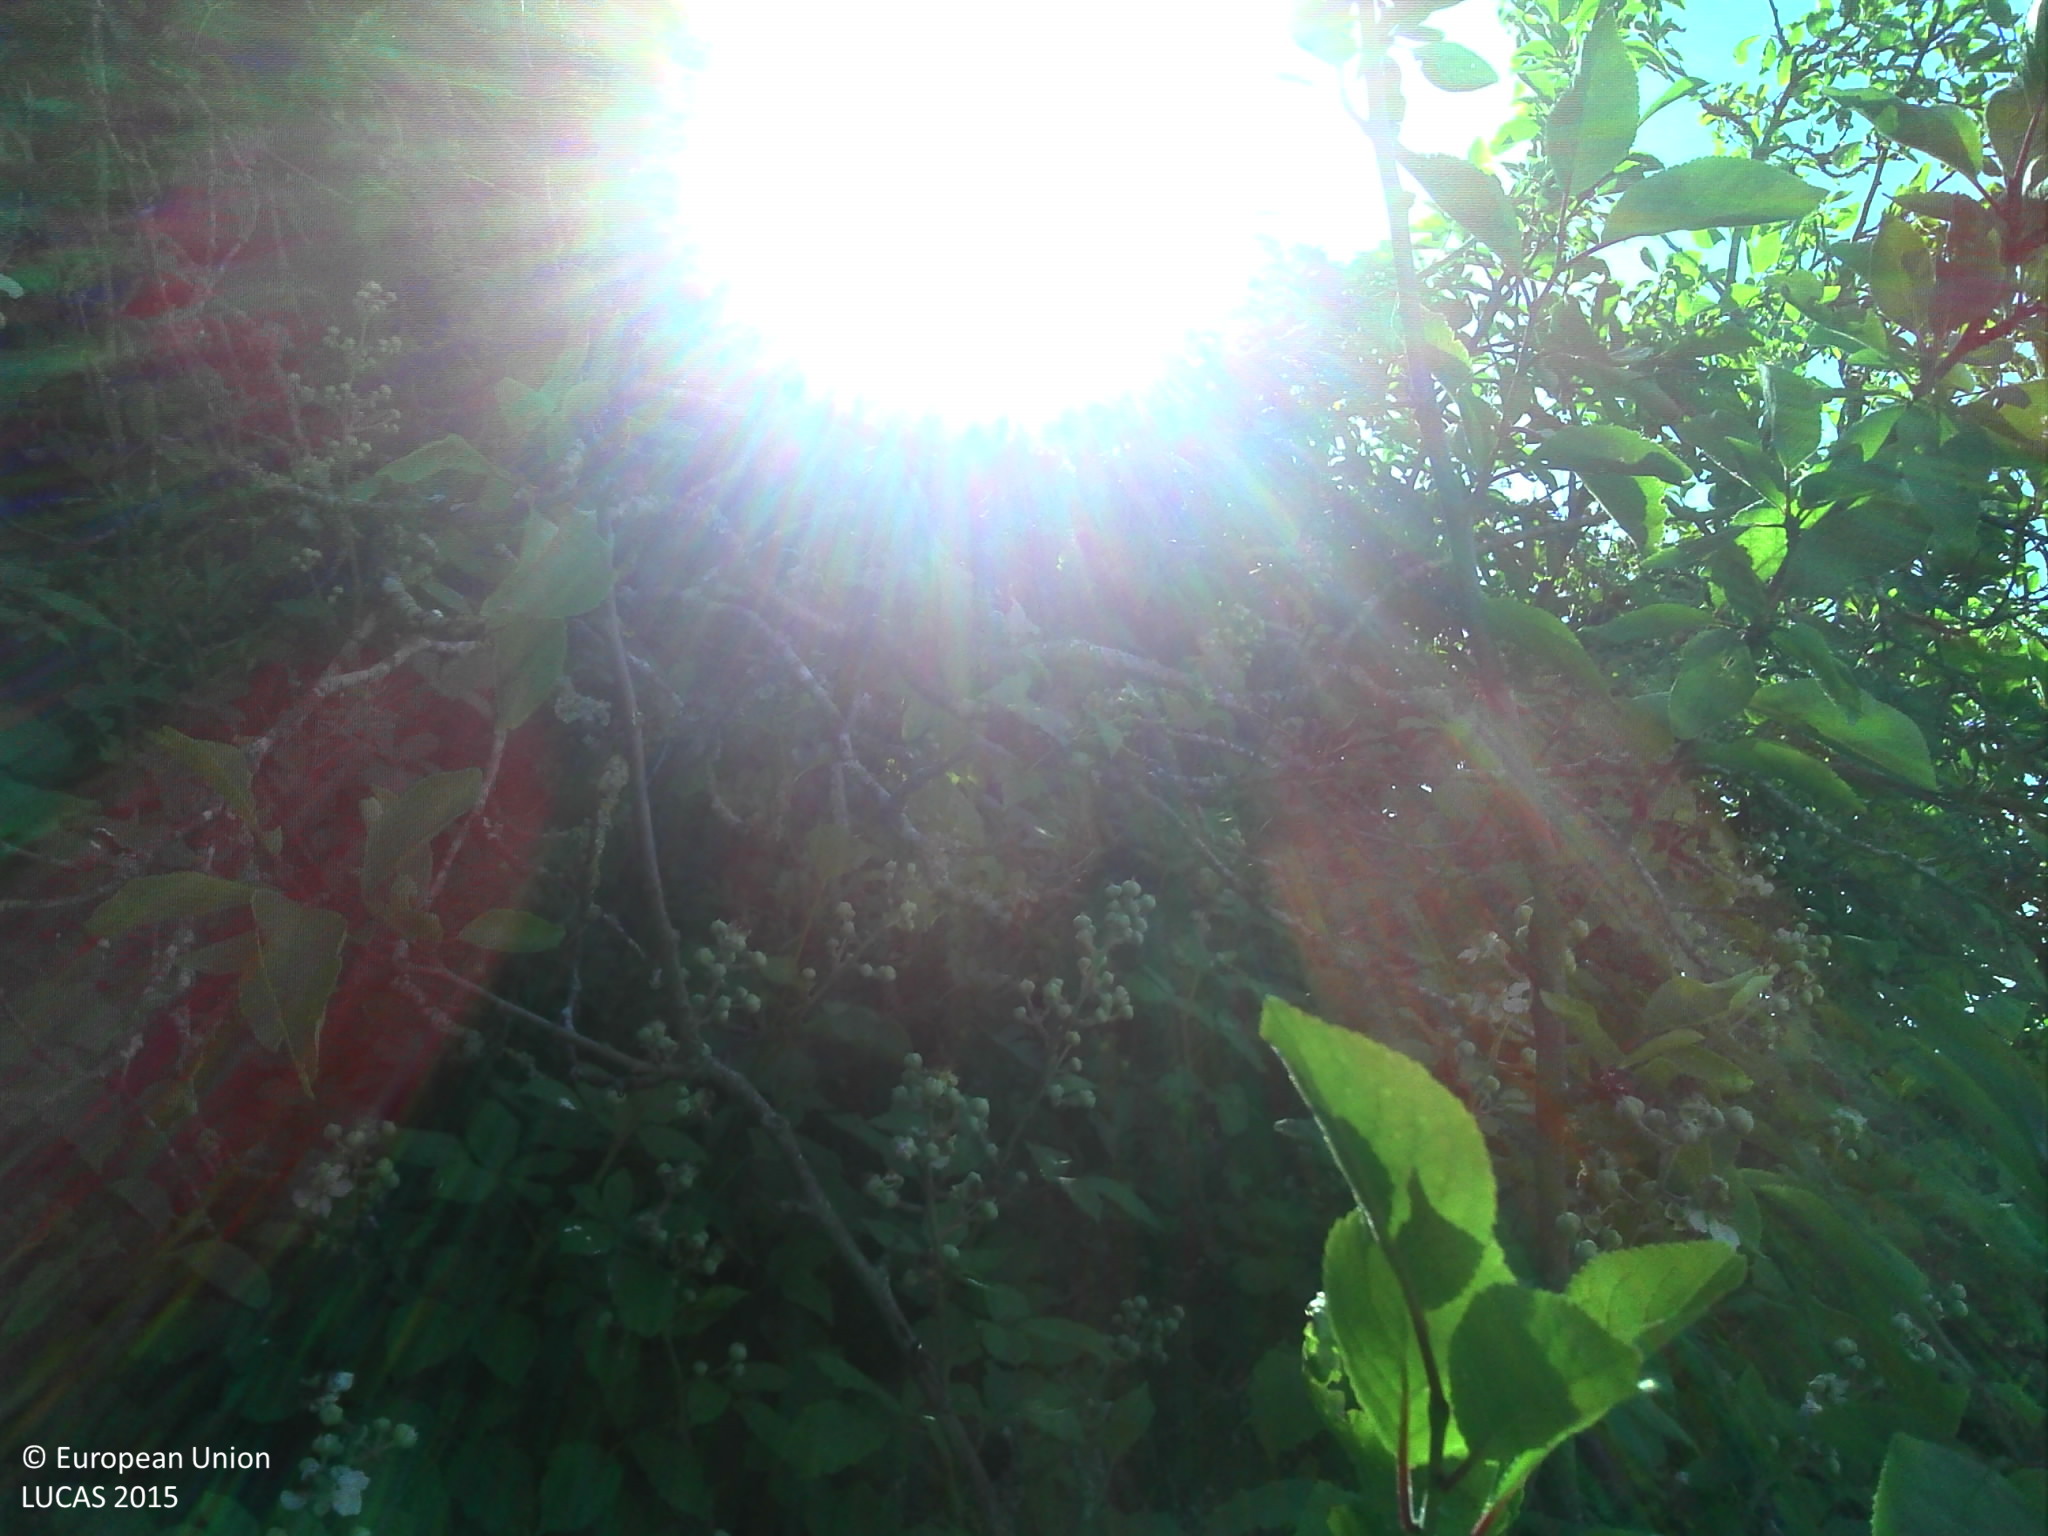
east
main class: Woodland
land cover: Broadleaved woodland
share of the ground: > 75 %
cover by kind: broadleaved forest trees 100 %
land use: Semi-natural and natural areas not in use
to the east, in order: Broadleaved woodland; Grass margins; Paved roads, cycling and walking lanes; Grass margins; Electric lines; Broadleaved woodland; Grass margins; Tracks; Grass margins; Barley
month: June
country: FR
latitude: 47.2397
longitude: 2.6884
